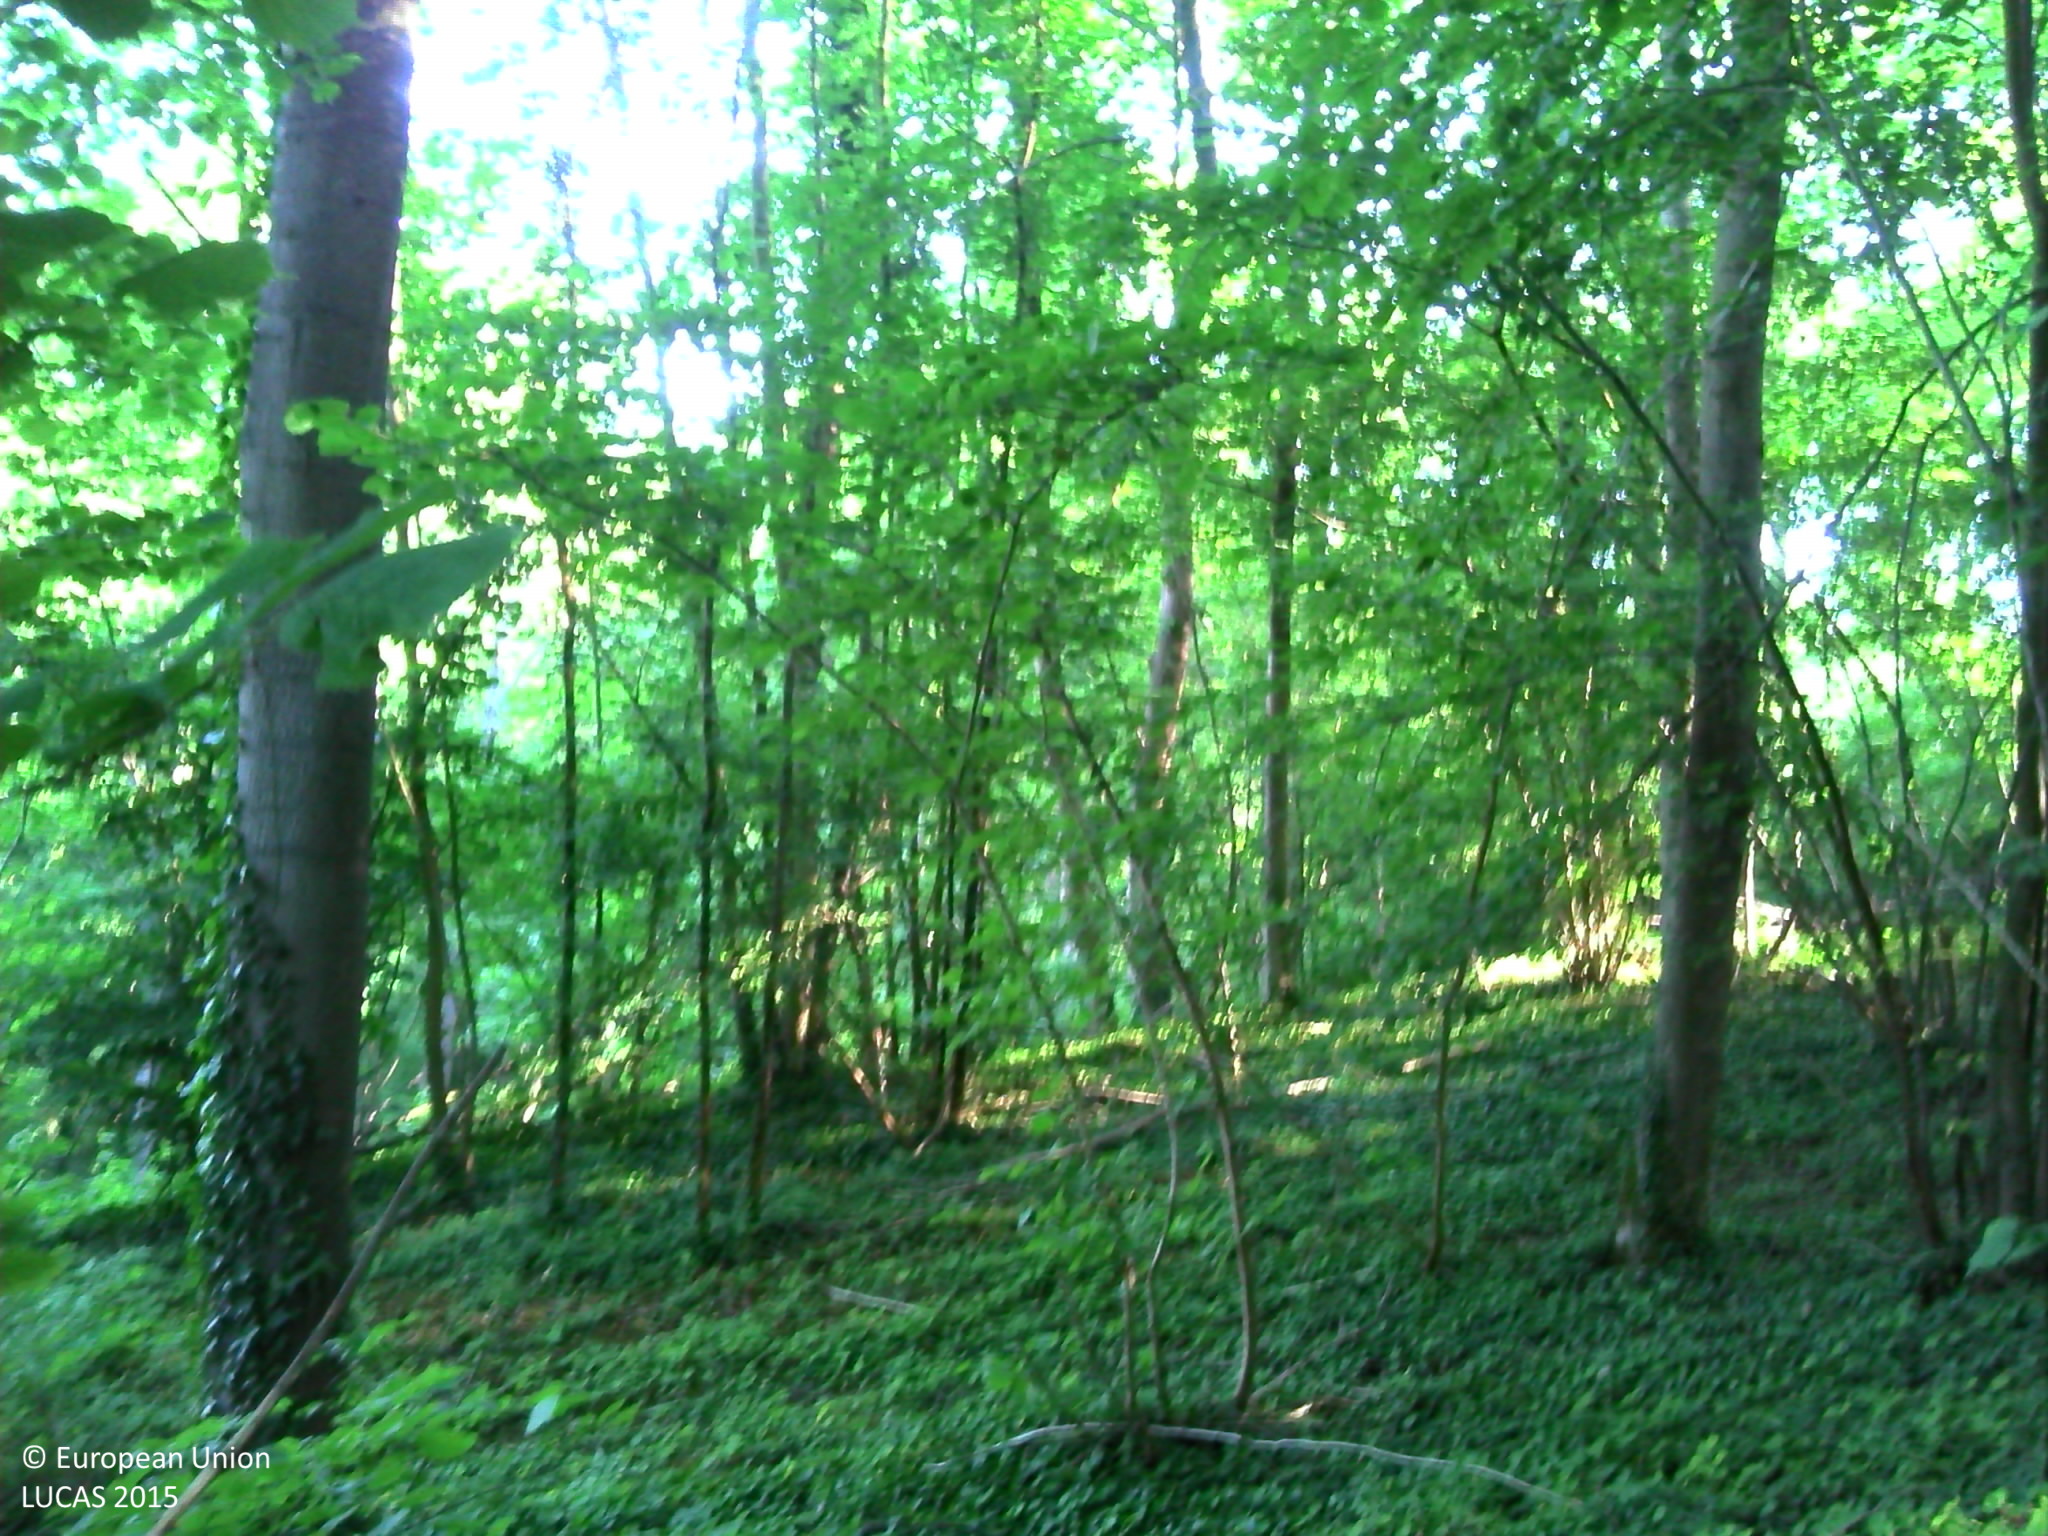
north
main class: Woodland
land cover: Broadleaved woodland
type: mesophytic deciduous forest
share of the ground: > 75 %
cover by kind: broadleaved forest trees 85 %, shrubs 10 %, herbaceous plants 5 %
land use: Forestry
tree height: > 5 m
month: June
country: FR
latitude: 49.2561
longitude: 2.8593
